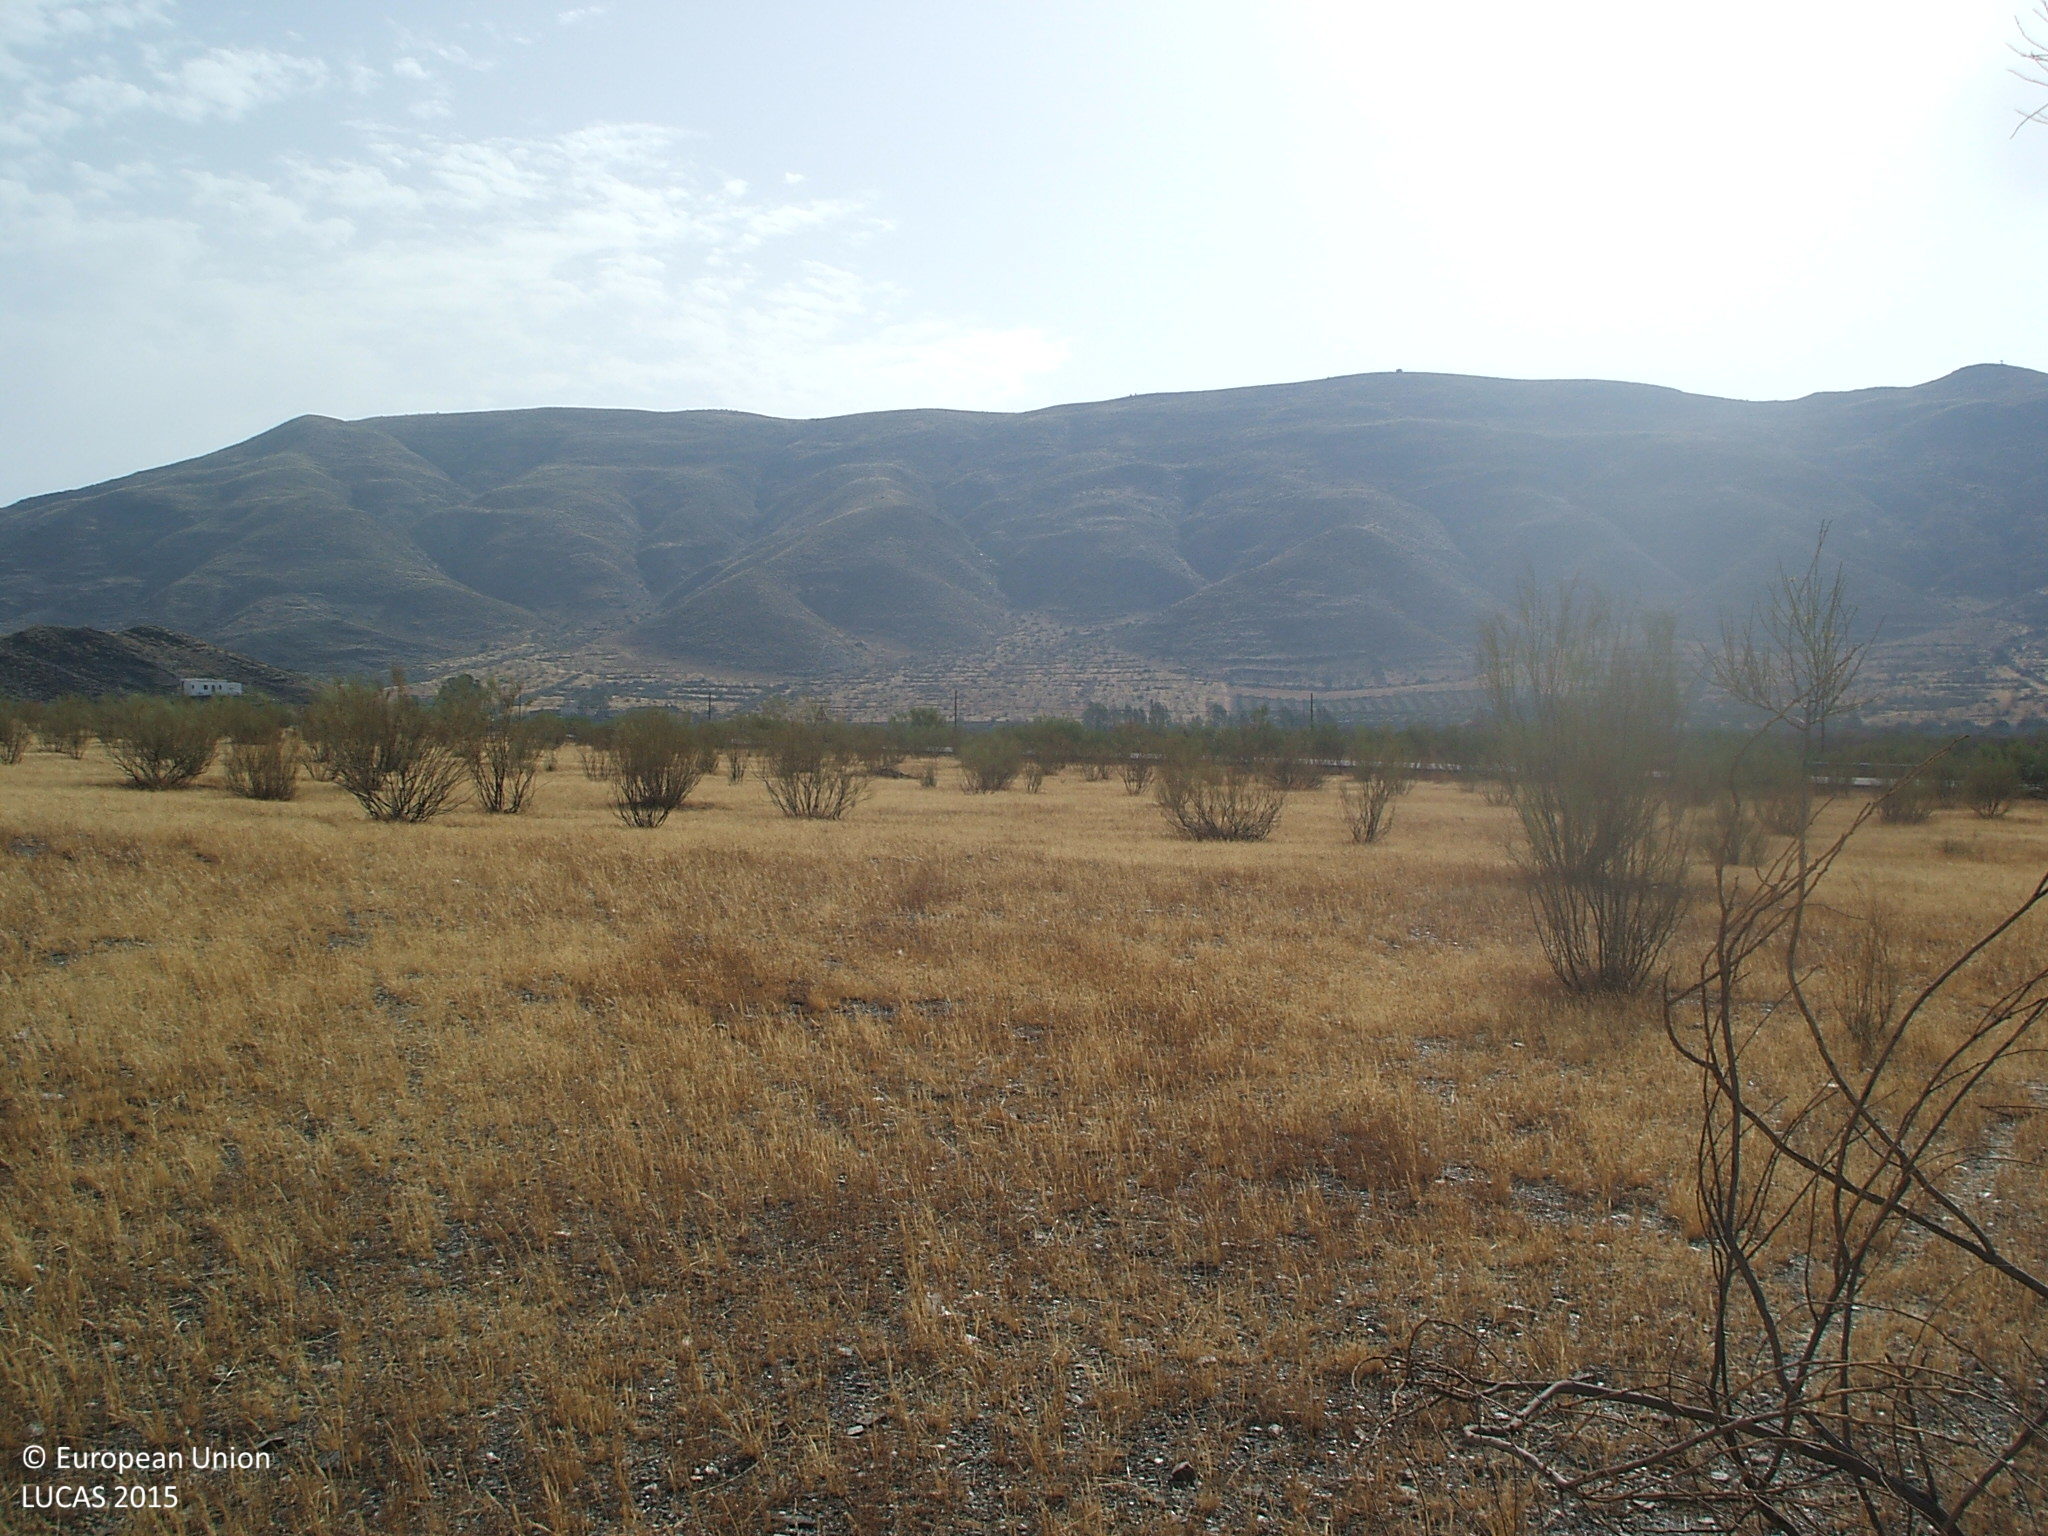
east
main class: Shrubland
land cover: Shrubland without tree cover
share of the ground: 10 - 25 %
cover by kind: herbaceous plants 85 %, shrubs 15 %
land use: Semi-natural and natural areas not in use
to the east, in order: Shrubland without tree cover; Electric lines; Shrubland without tree cover; Shruby margins; Paved roads, cycling and walking lanes; Shruby margins; Olive groves; Shruby margins; Nuts trees
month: July
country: ES
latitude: 37.1227
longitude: -2.3481
